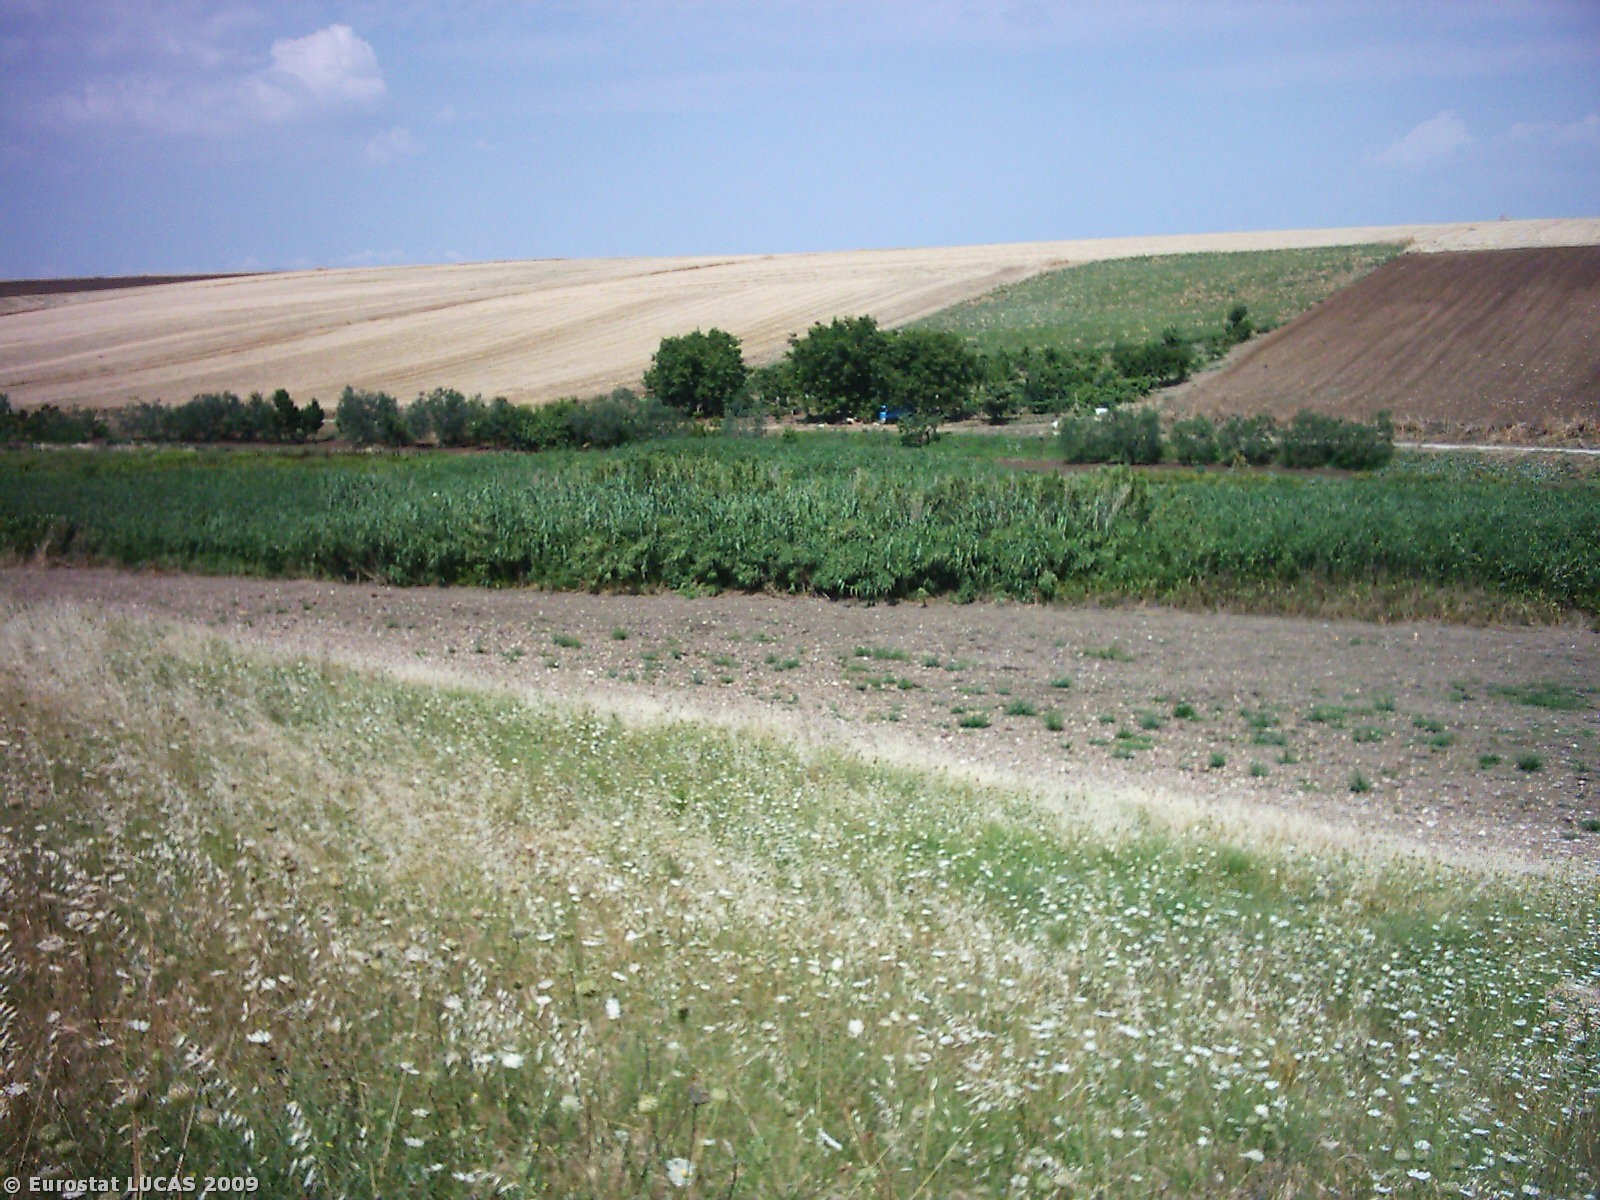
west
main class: Grassland
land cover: Spontaneously vegetated surfaces
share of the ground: > 75 %
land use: Fallow land
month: July
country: IT
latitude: 41.2300
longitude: 15.6237
